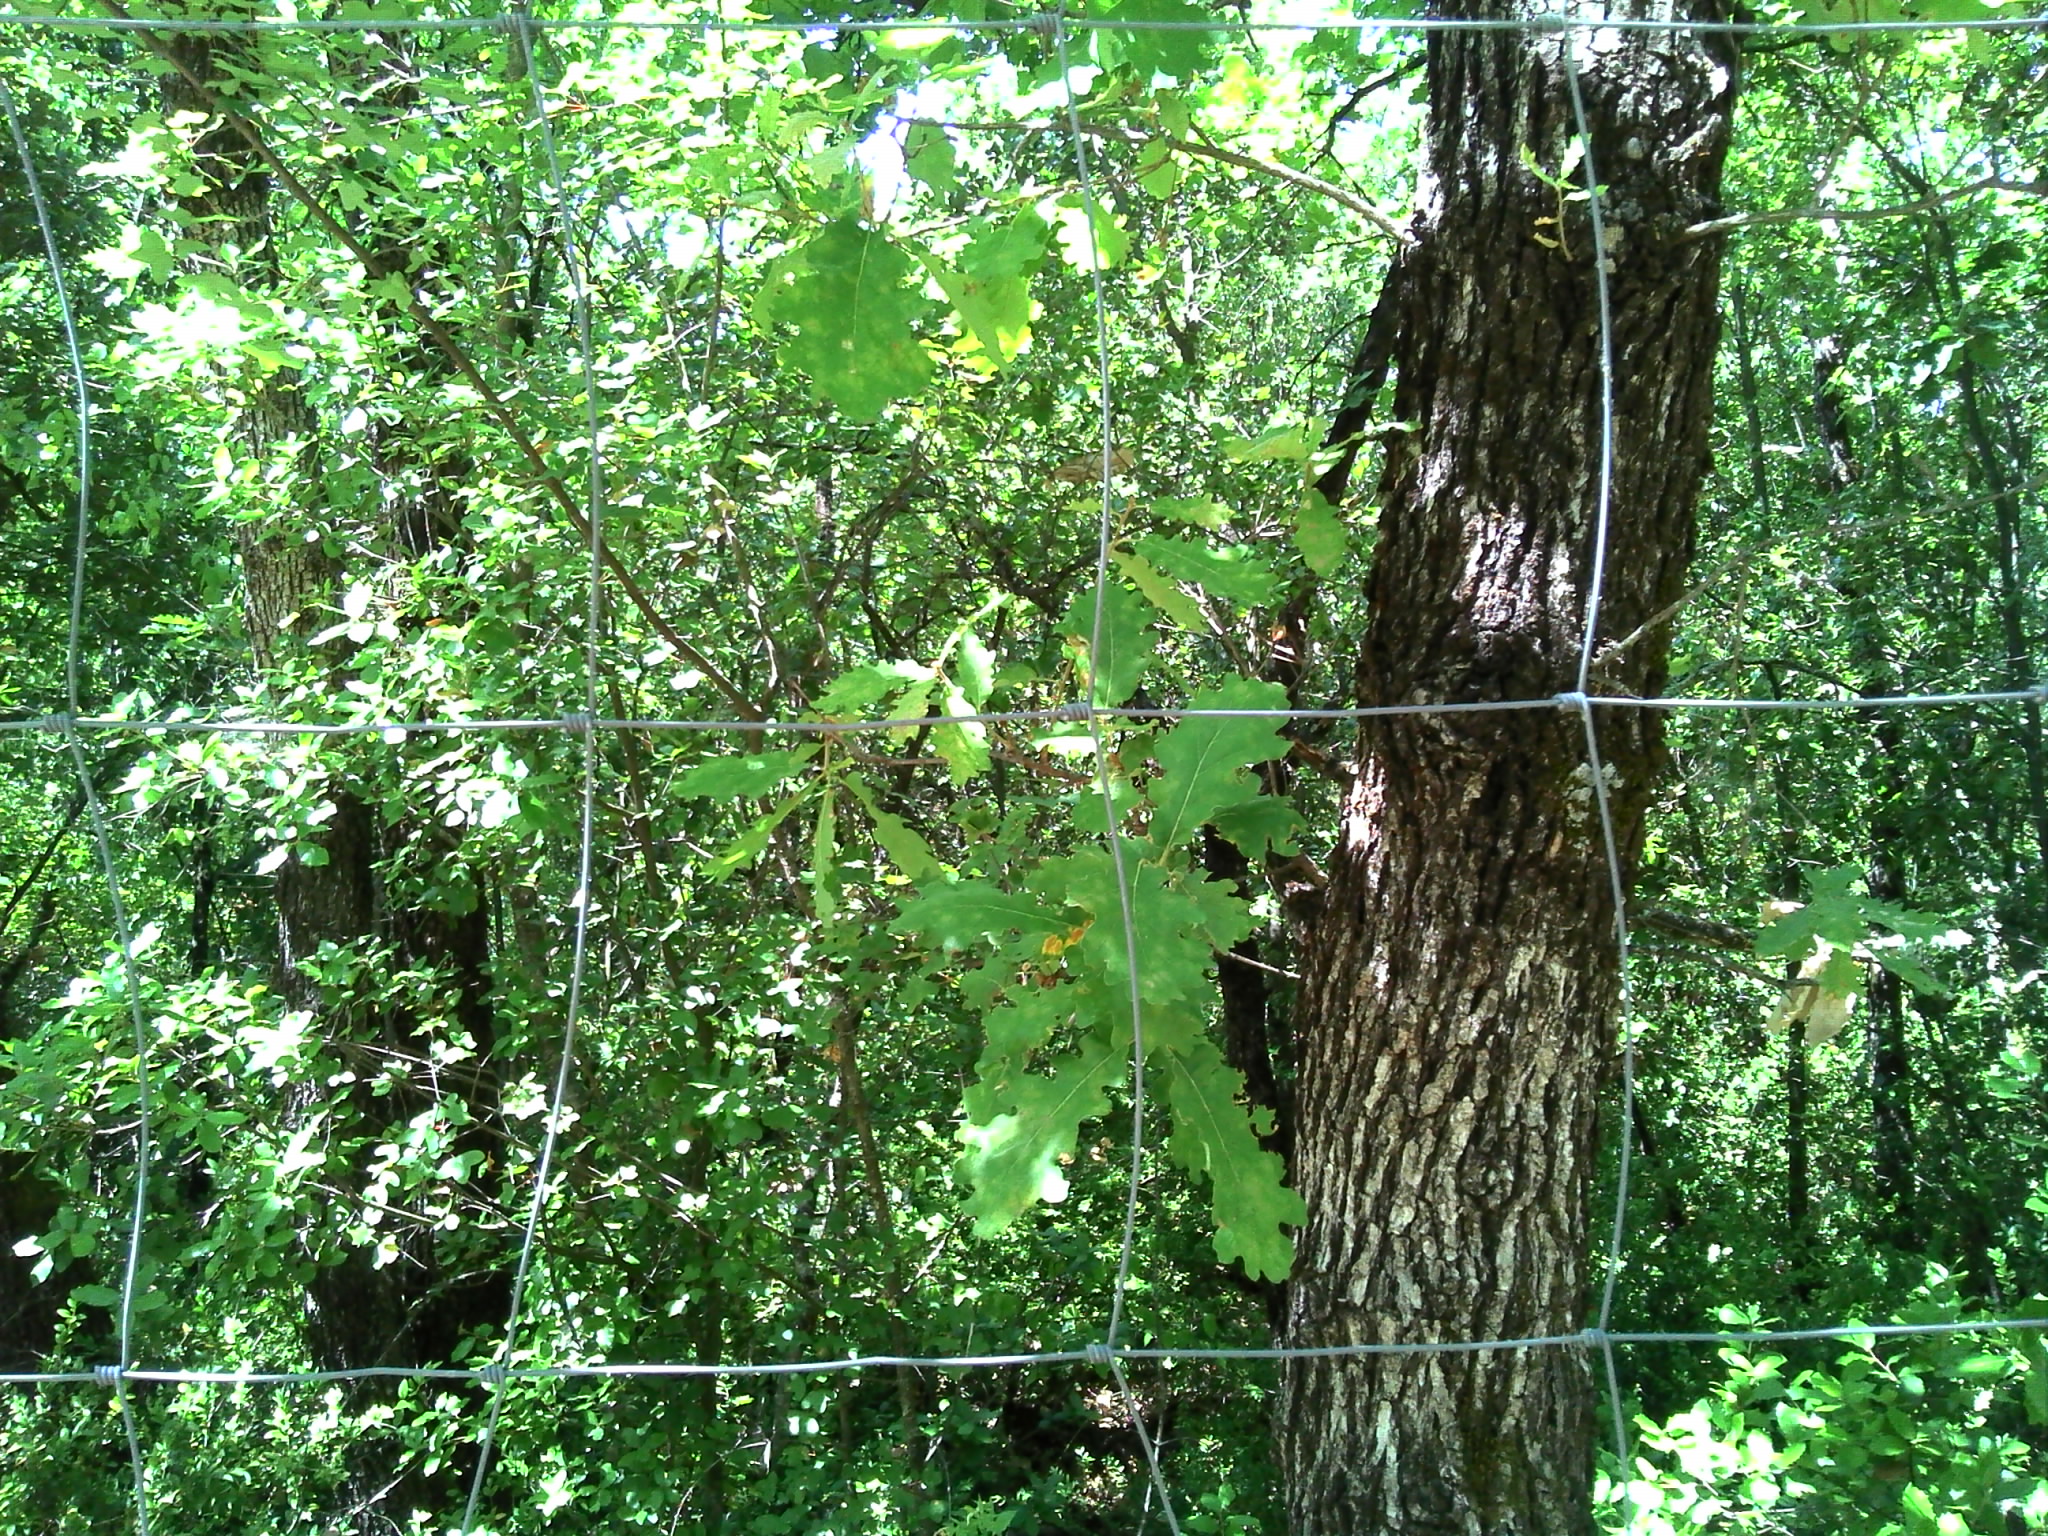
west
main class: Woodland
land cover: Broadleaved woodland
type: acidophilous oak and oak-birch forest
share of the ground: > 75 %
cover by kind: broadleaved forest trees 70 %, herbaceous plants 15 %, consolidated bare surface 15 %
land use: Semi-natural and natural areas not in use
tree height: > 5 m
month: July
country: FR
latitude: 44.1753
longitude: 4.2915
